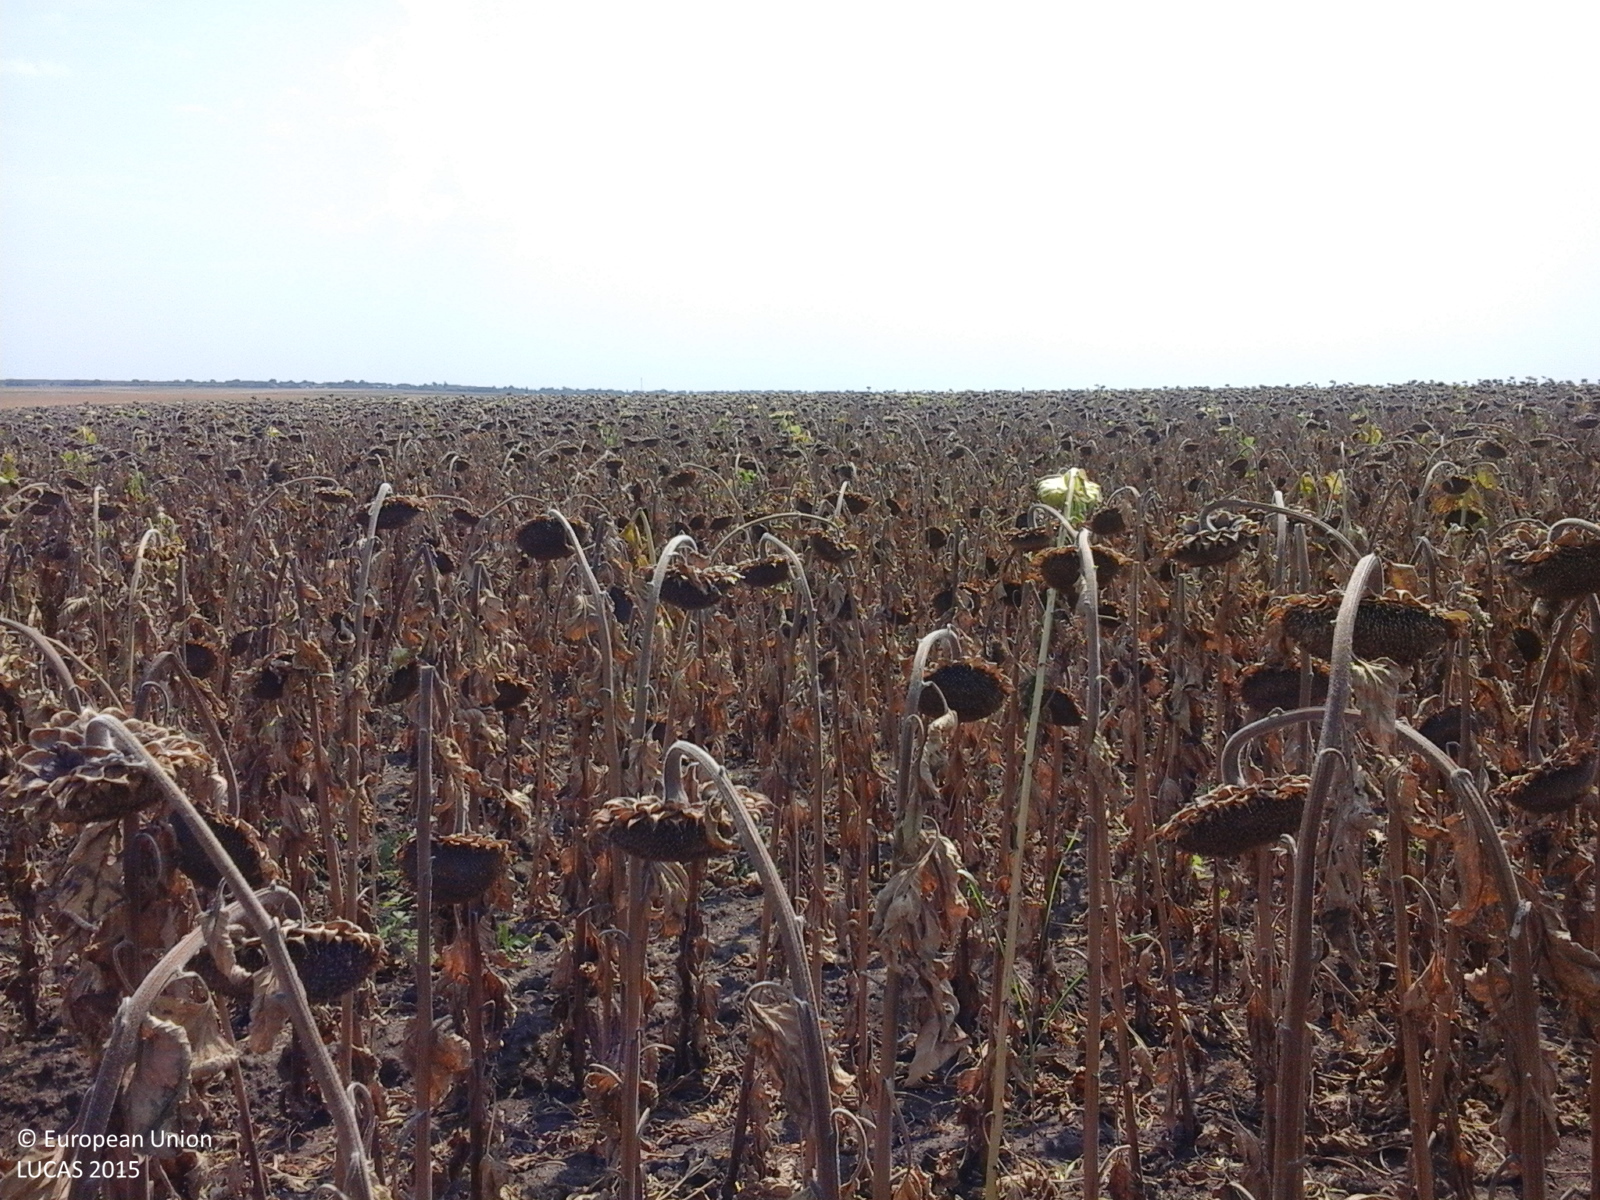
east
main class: Cropland
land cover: Sunflower
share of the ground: > 75 %
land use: Agriculture (excluding fallow land and kitchen gardens)
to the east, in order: Sunflower
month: August
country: RO
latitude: 44.1523
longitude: 23.2622
